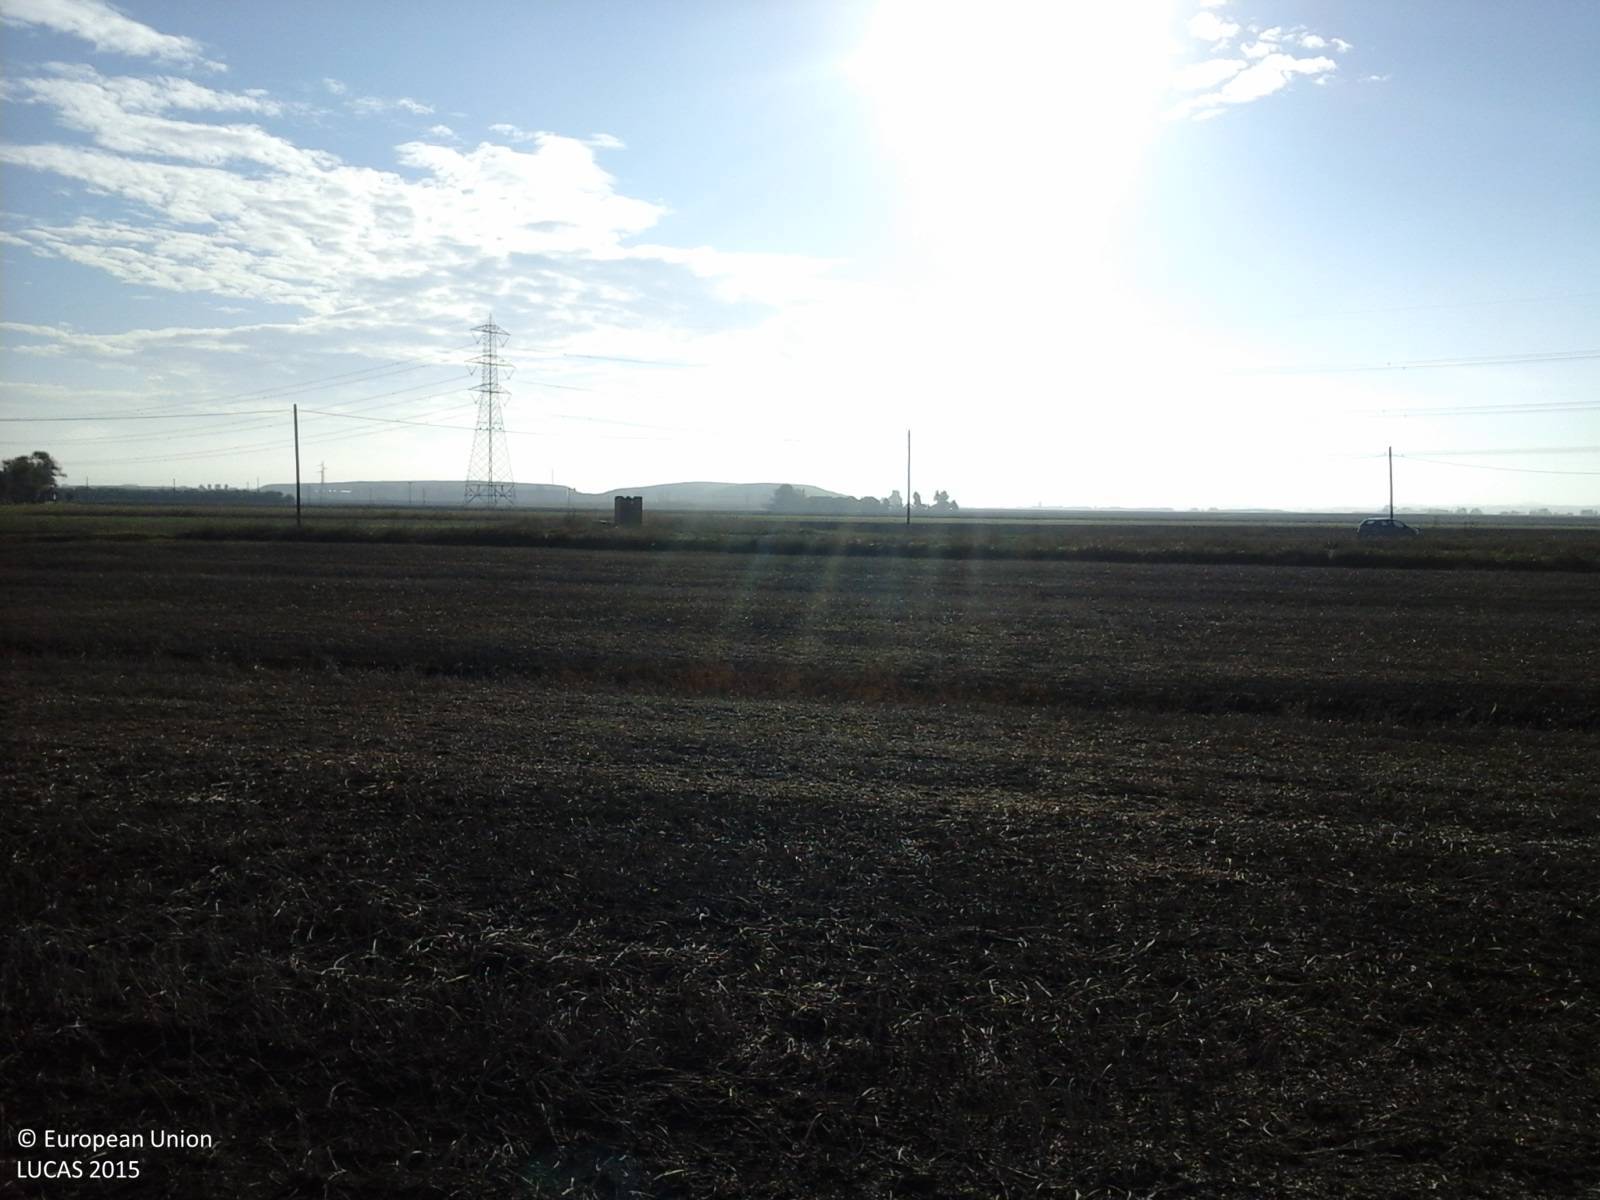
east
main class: Cropland
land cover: Mixed cereals for fodder
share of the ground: 50 - 75 %
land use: Agriculture (excluding fallow land and kitchen gardens)
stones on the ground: < 10 %
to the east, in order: Mixed cereals for fodder; Ditches and canals; Mixed cereals for fodder; Ditches and canals; Mixed cereals for fodder; Ditches and canals; Grass margins; Paved roads, cycling and walking lanes; Grass margins; Electric lines; Spontaneously vegetated surfaces; Shruby margins; Ditches and canals; Shruby margins; Common wheat; Ditches and canals; Common wheat; Ditches and canals; Common wheat; Ditches and canals; Common wheat; Ditches and canals; Common wheat; Ditches and canals; Common wheat
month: October
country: IT
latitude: 43.6454
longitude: 10.5564
